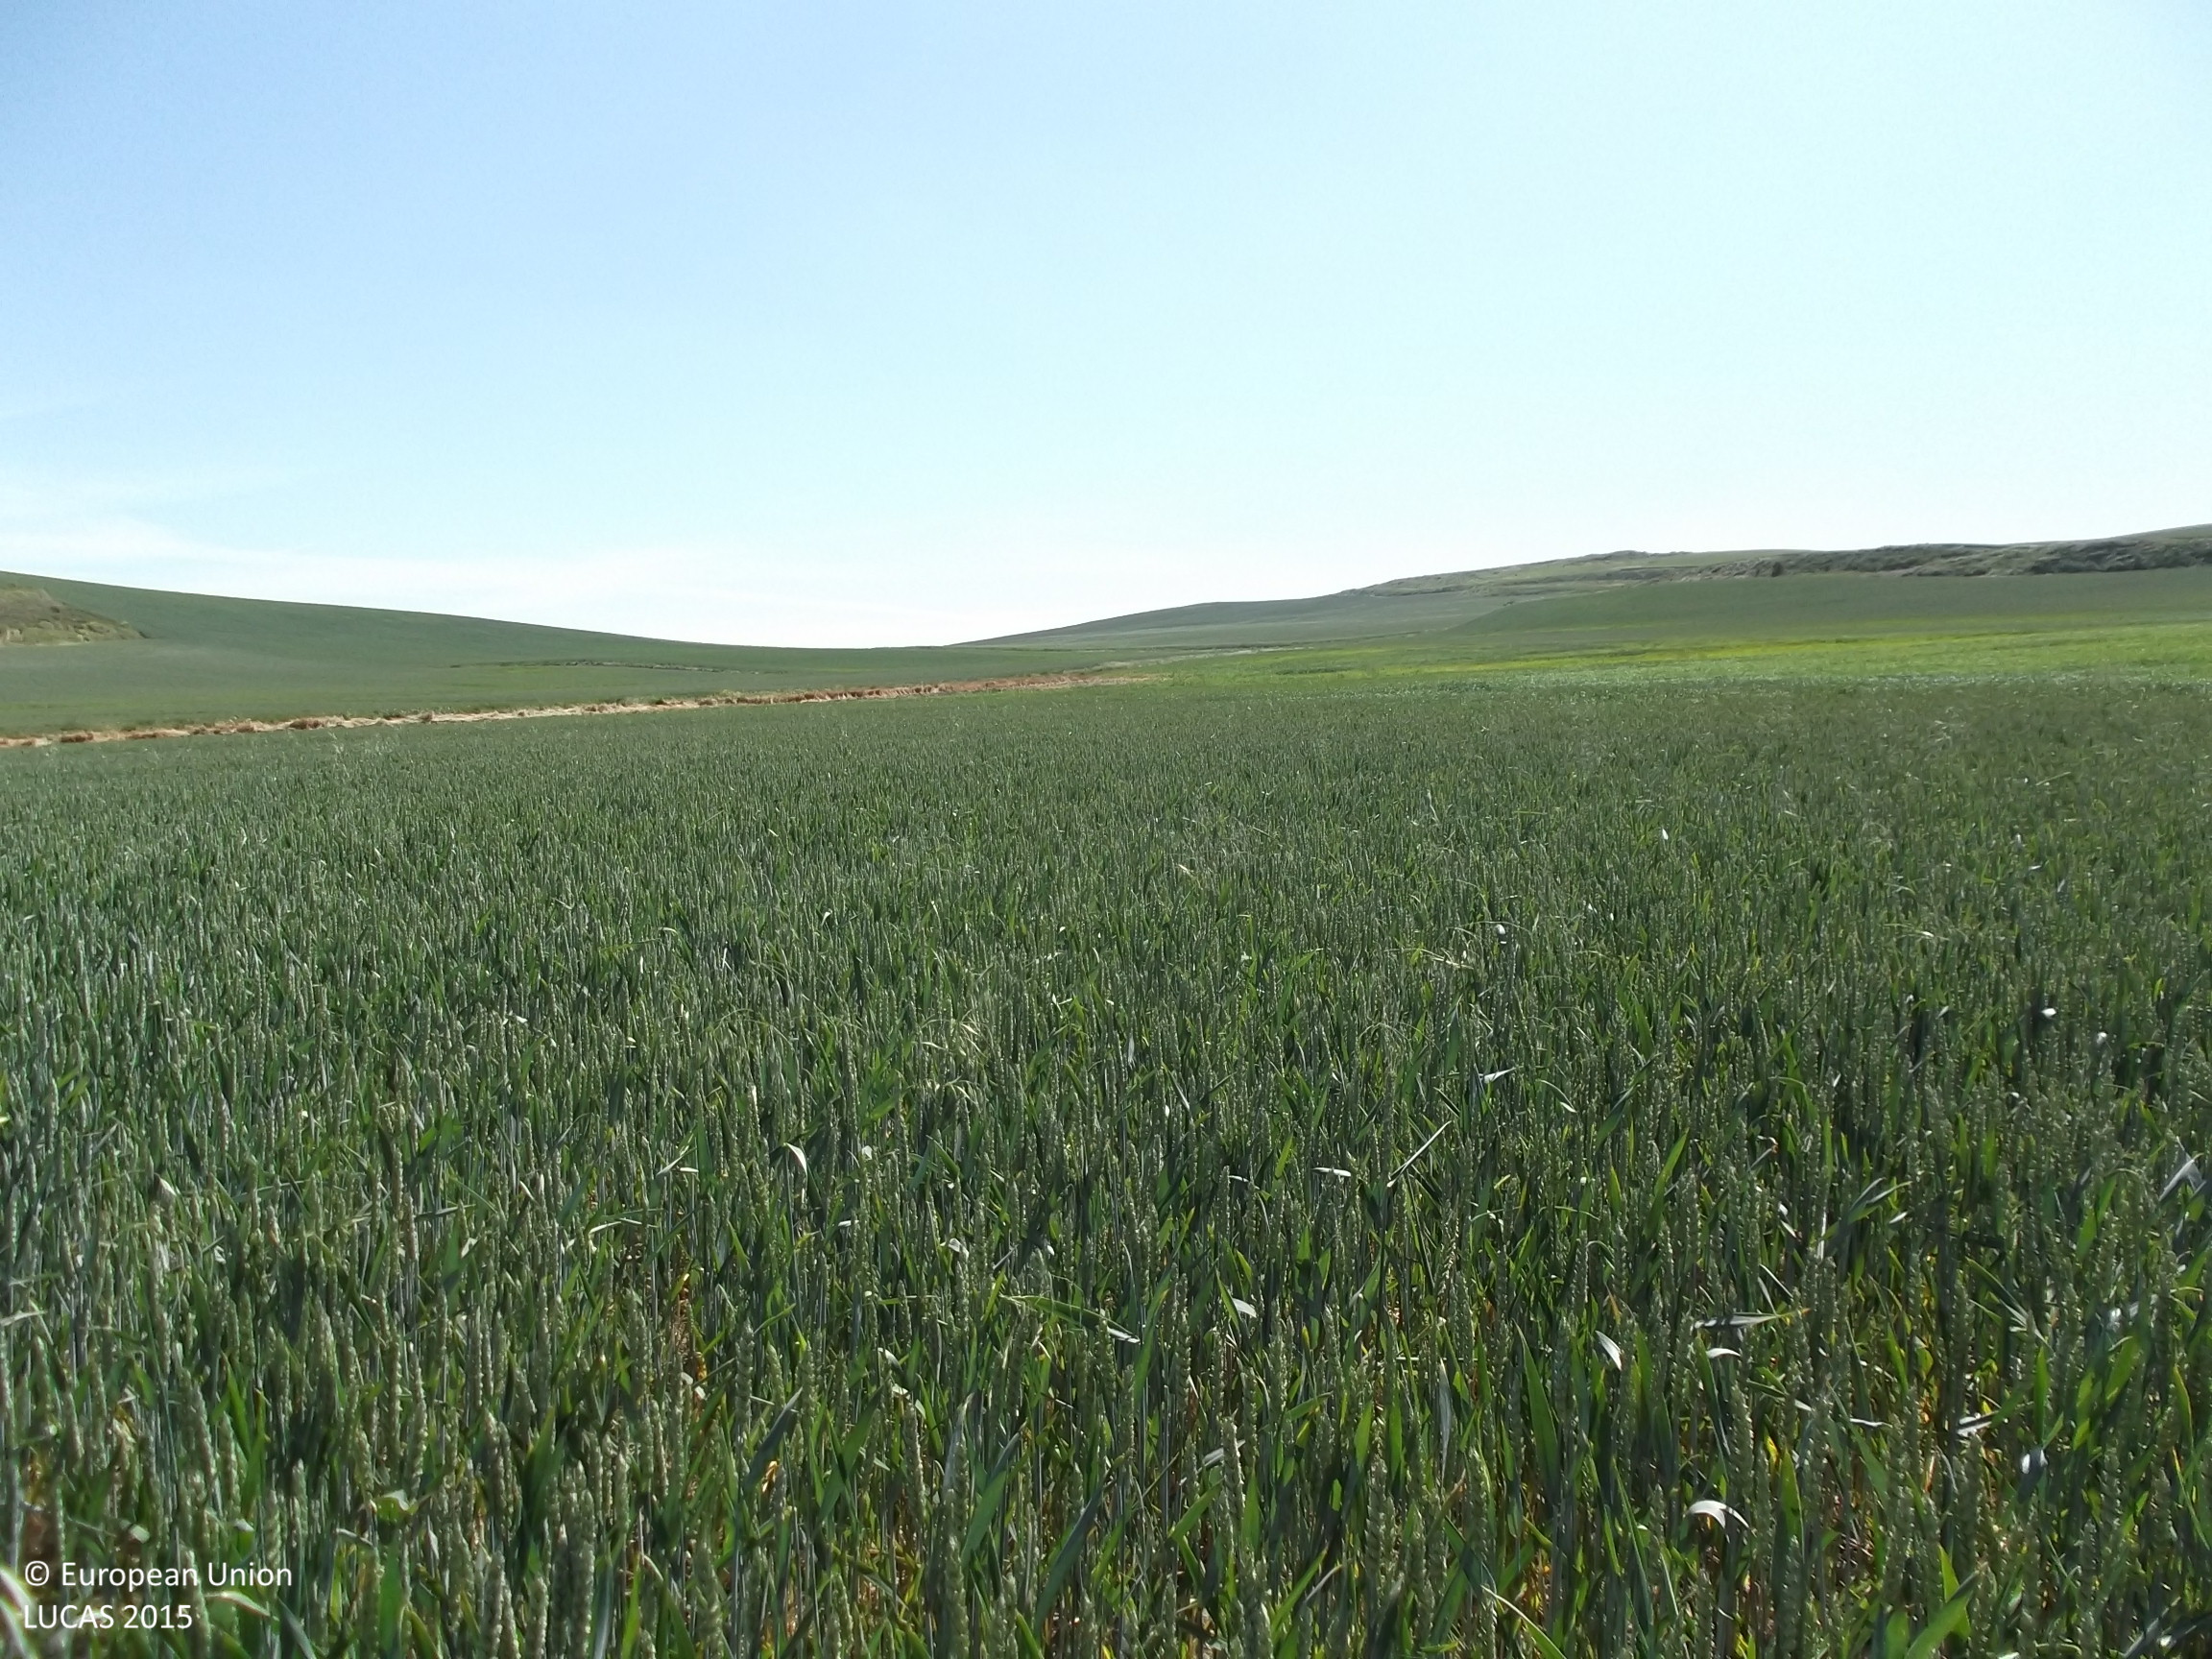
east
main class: Cropland
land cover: Common wheat
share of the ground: > 75 %
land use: Agriculture (excluding fallow land and kitchen gardens)
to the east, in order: Common wheat; Shruby margins; Tracks; Shruby margins
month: May
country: ES
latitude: 42.4808
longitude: -3.0569
